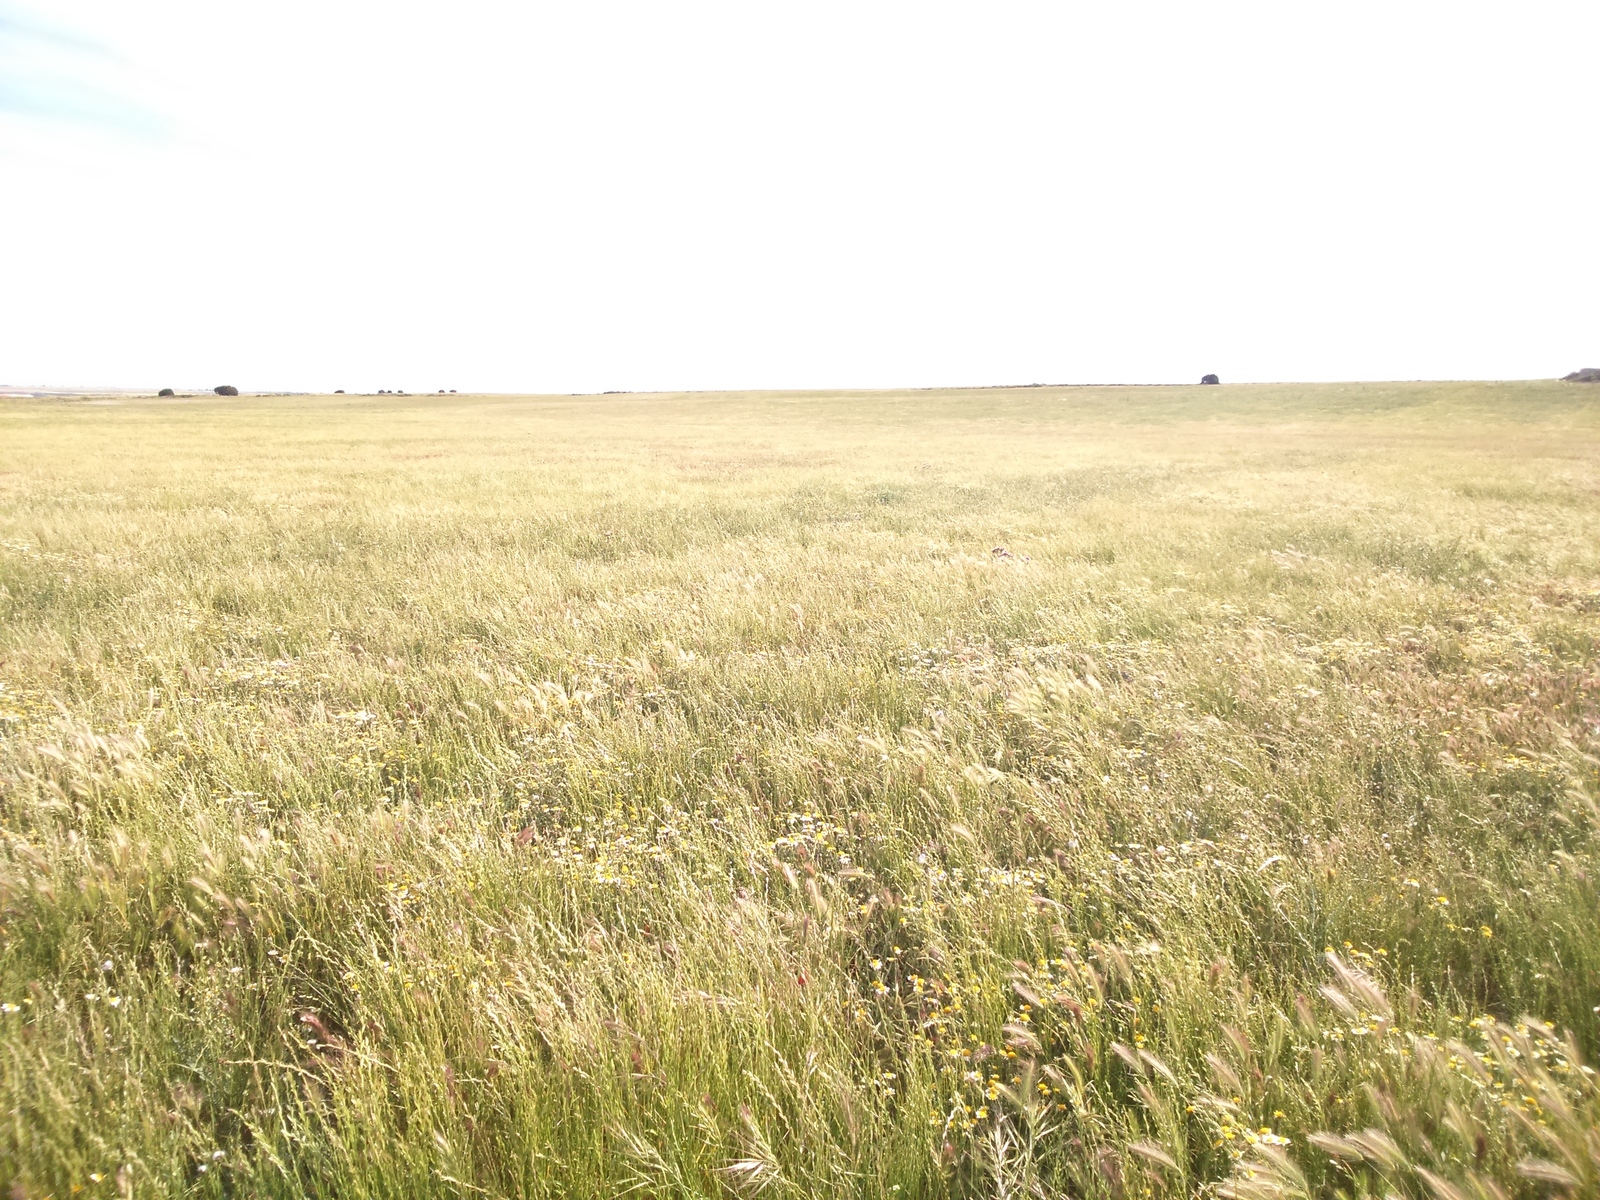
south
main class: Grassland
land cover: Spontaneously vegetated surfaces
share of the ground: > 75 %
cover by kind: herbaceous plants 100 %
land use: Fallow land
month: April
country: ES
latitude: 41.4641
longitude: -0.2044
